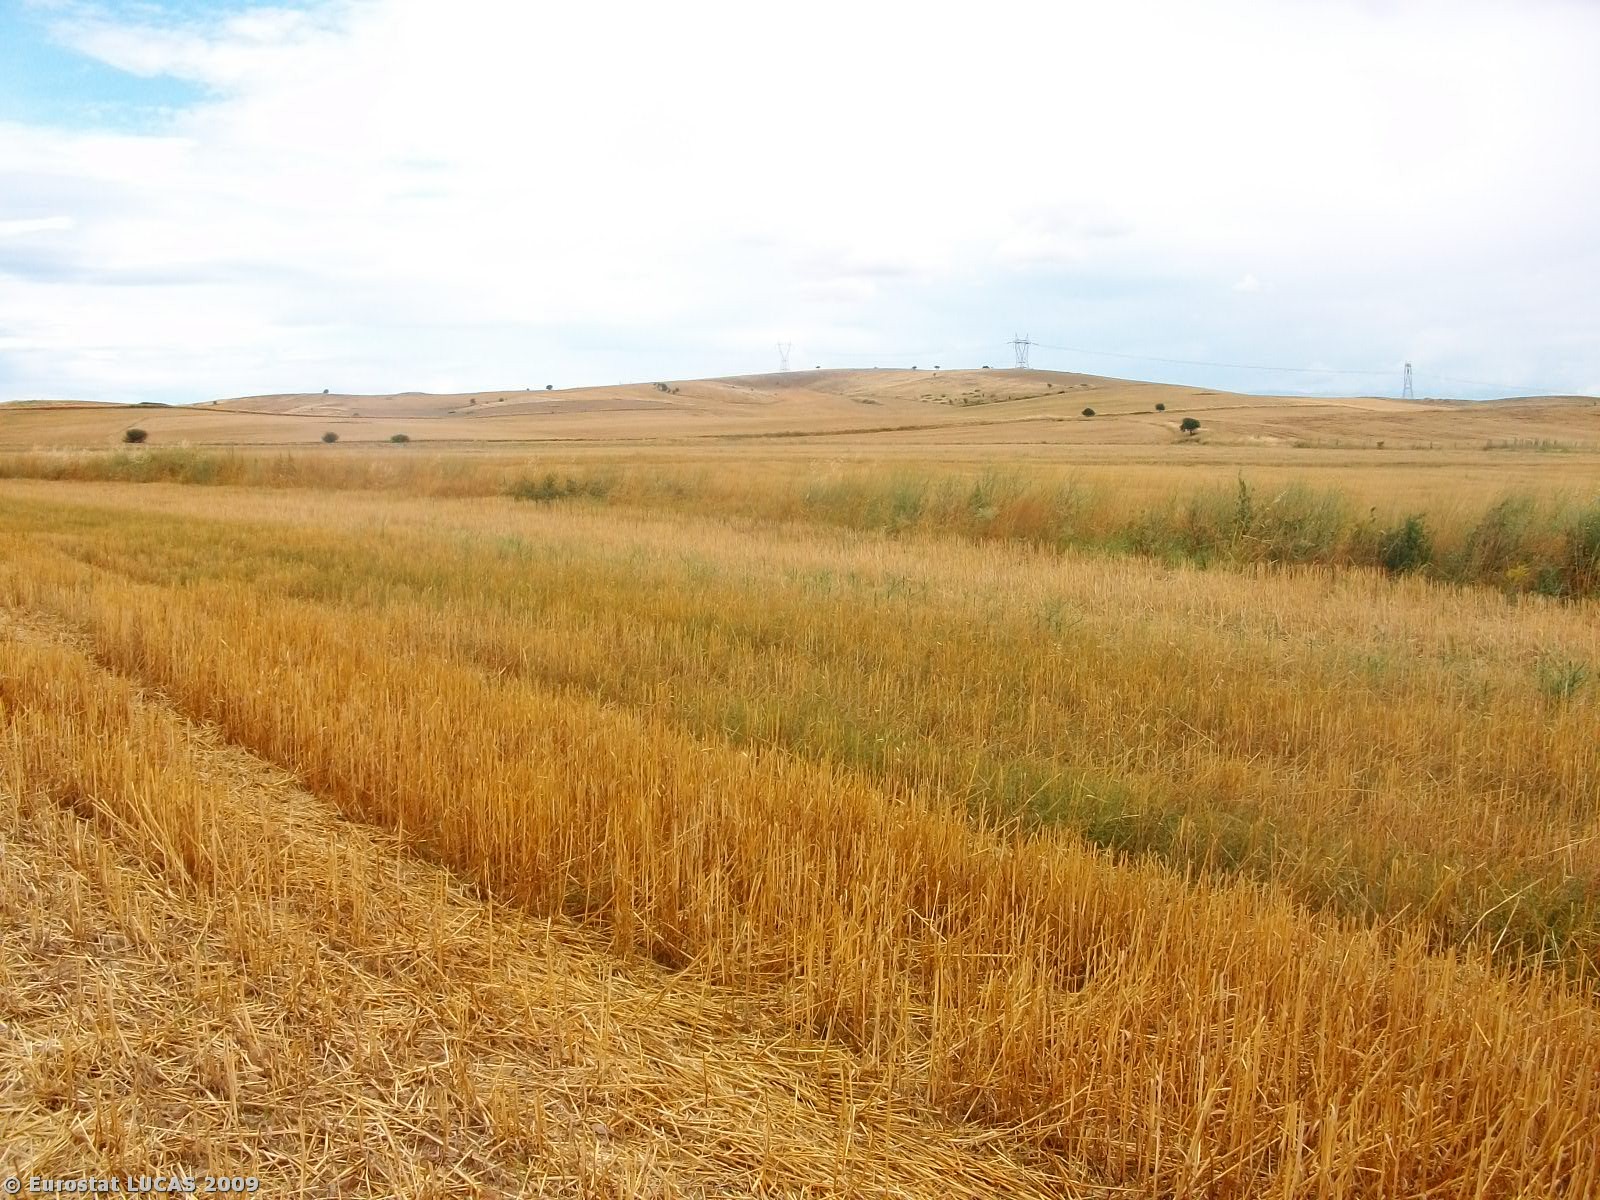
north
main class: Cropland
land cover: Durum wheat
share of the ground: > 75 %
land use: Agriculture (excluding fallow land and kitchen gardens)
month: June
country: GR
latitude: 40.9340
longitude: 22.7280
